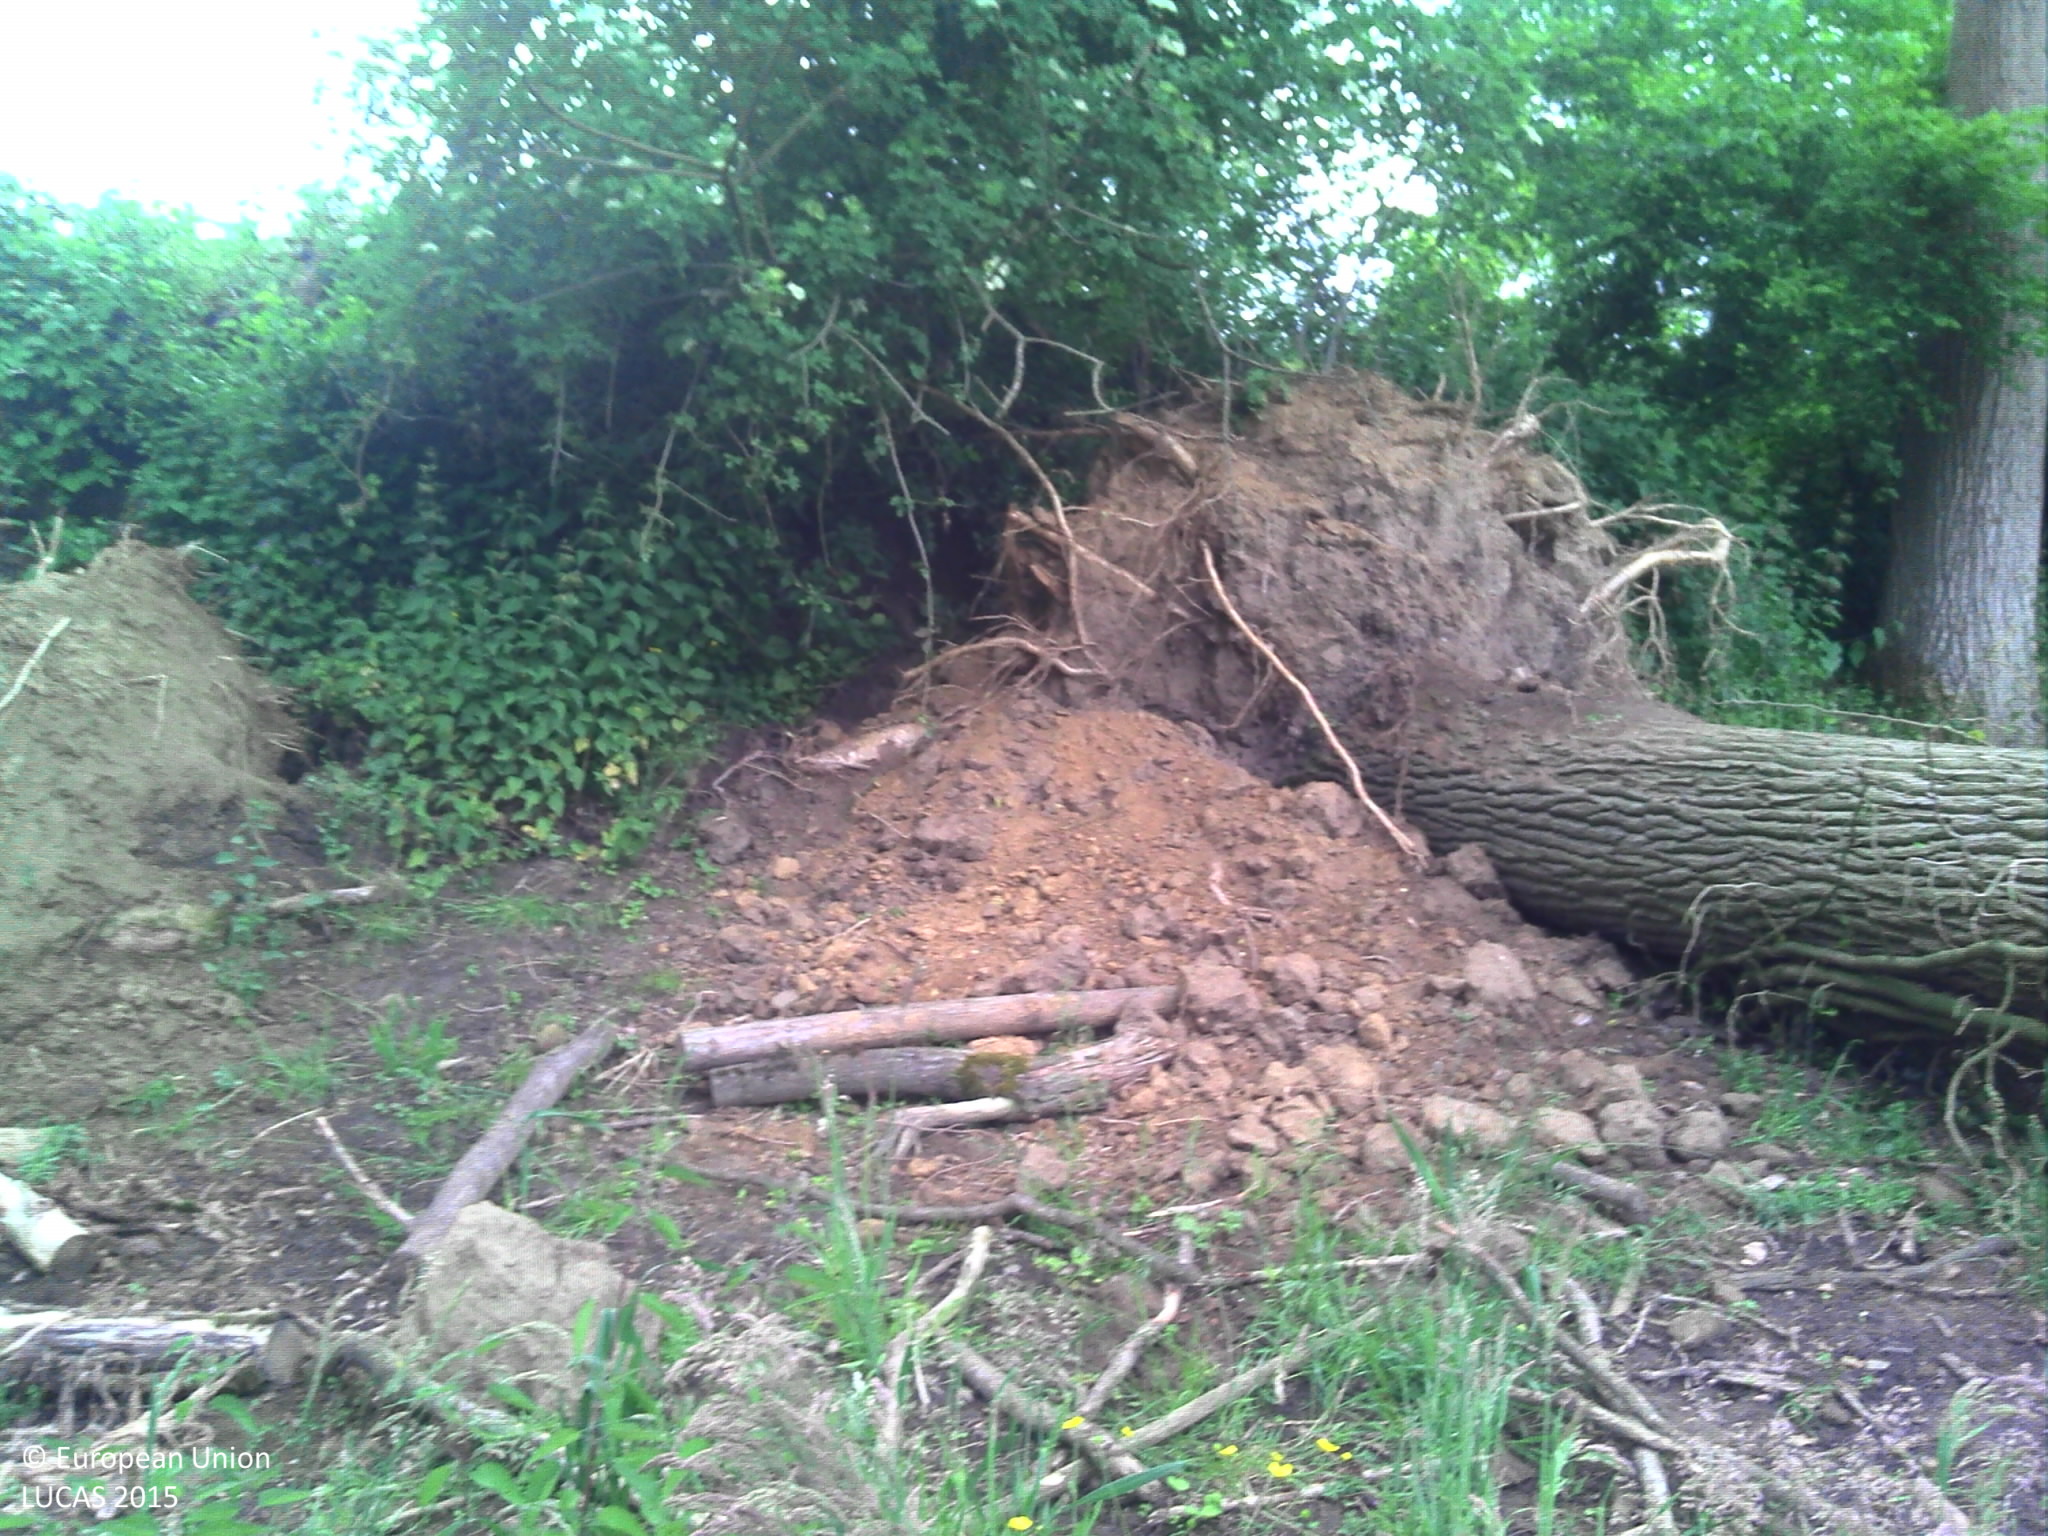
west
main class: Grassland
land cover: Grassland without tree/shrub cover
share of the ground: > 75 %
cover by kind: herbaceous plants 100 %
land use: Agriculture (excluding fallow land and kitchen gardens)
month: June
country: BE
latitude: 50.7788
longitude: 3.9097
